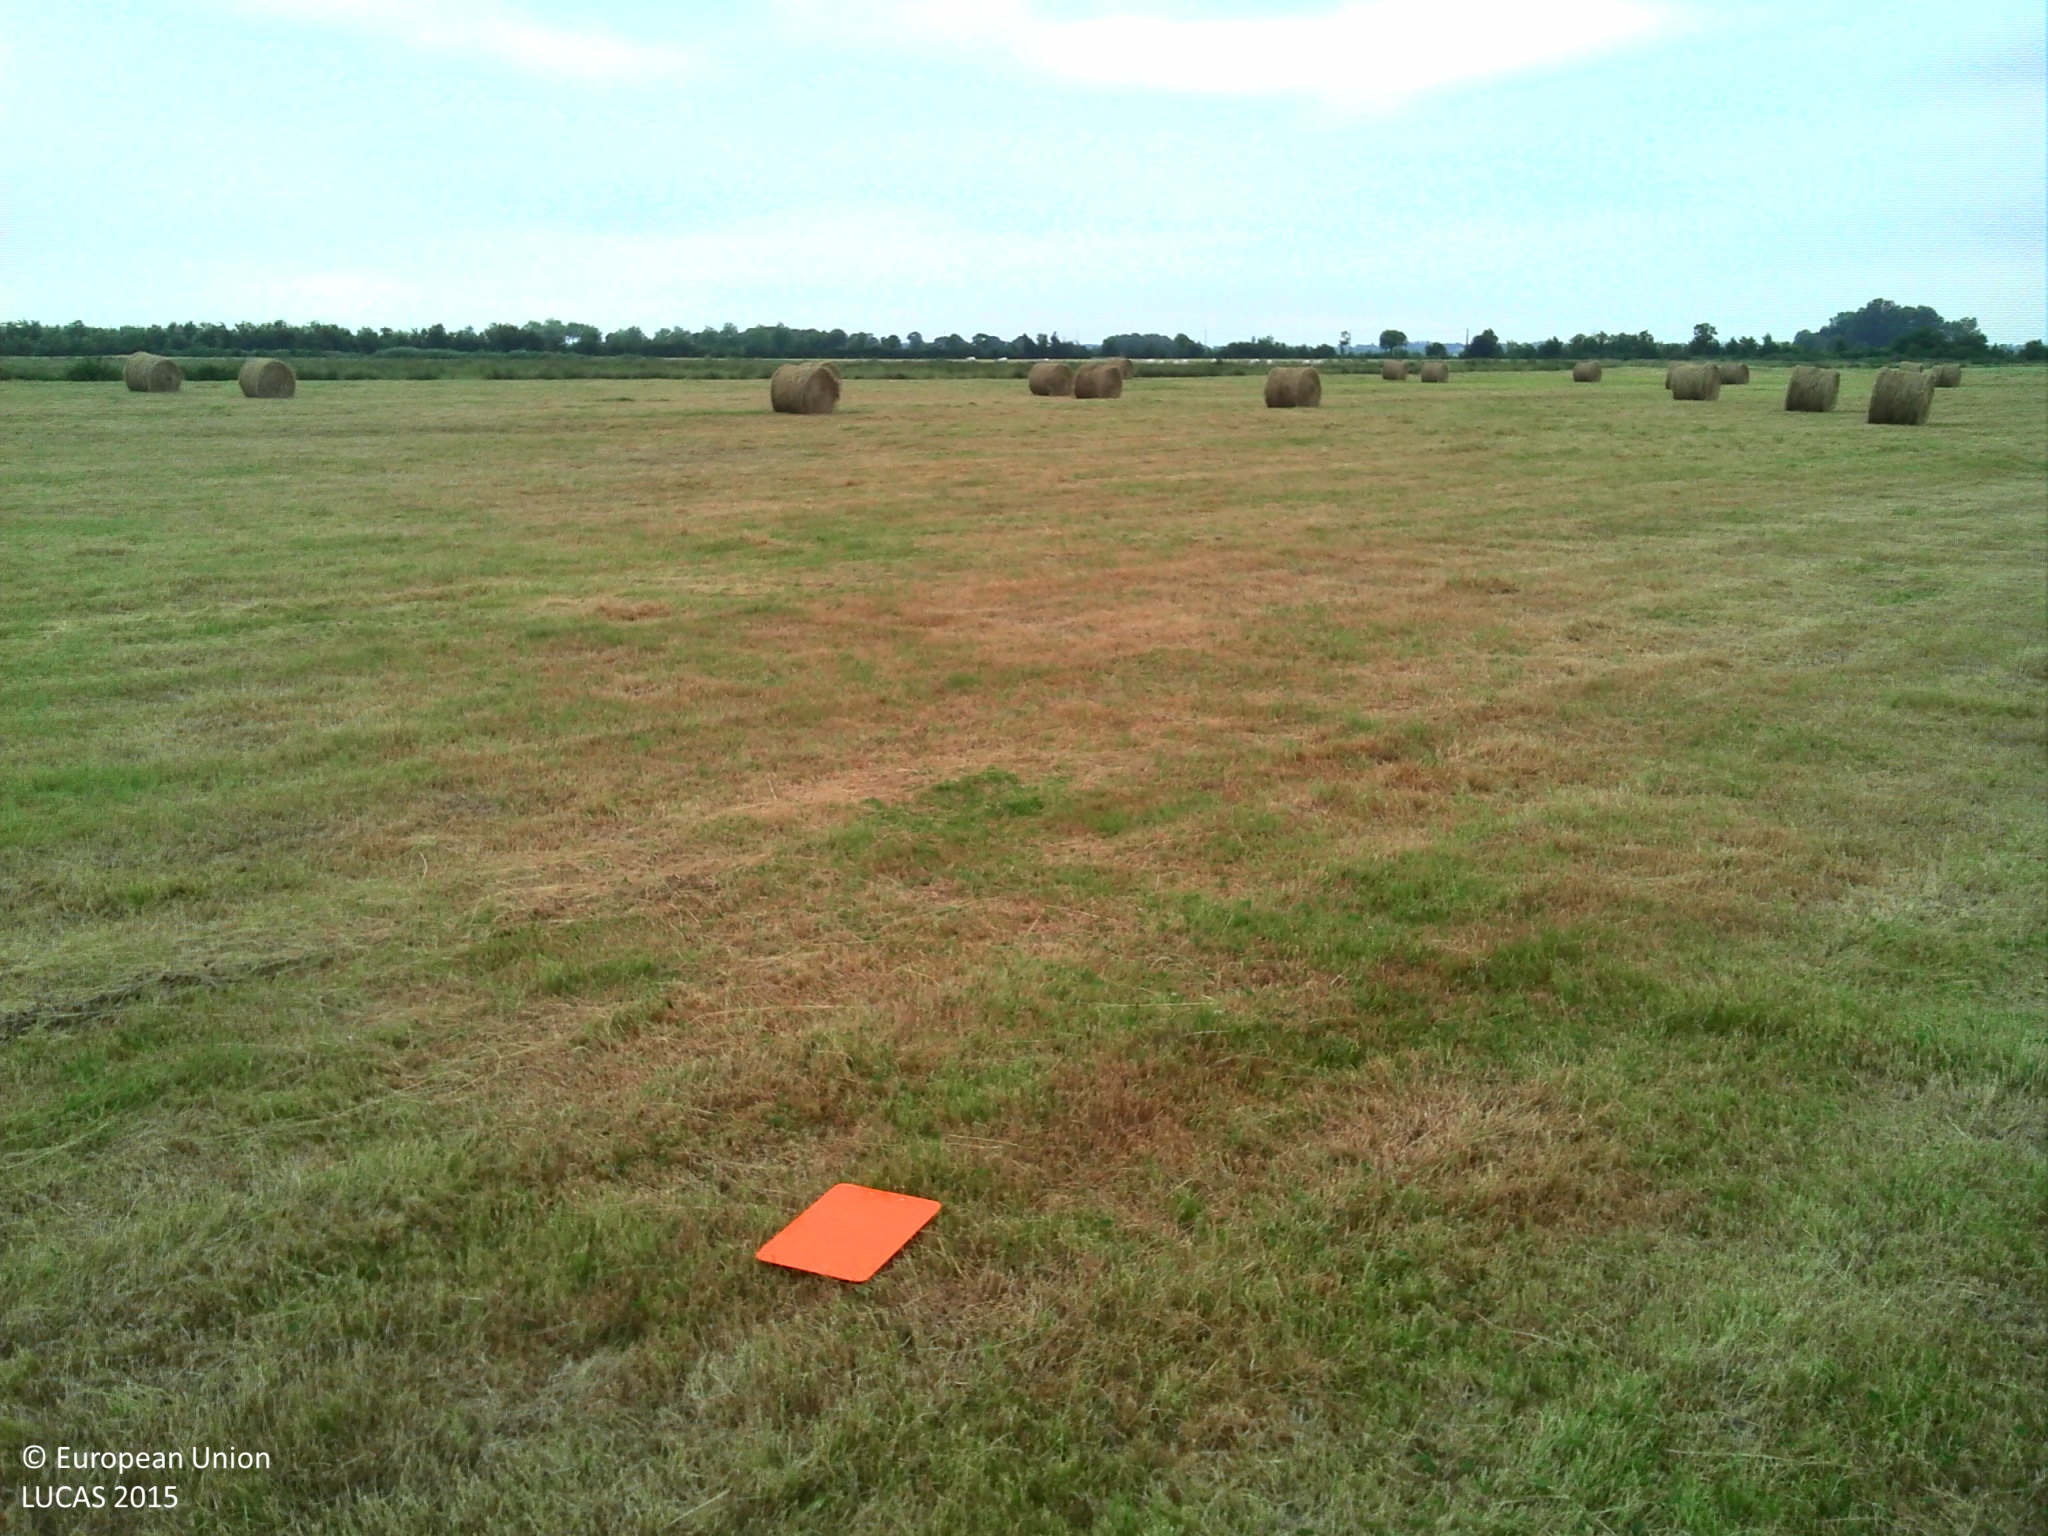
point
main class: Grassland
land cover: Grassland without tree/shrub cover
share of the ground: > 75 %
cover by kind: herbaceous plants 100 %
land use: Agriculture (excluding fallow land and kitchen gardens)
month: June
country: FR
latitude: 45.9733
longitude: -0.9081
